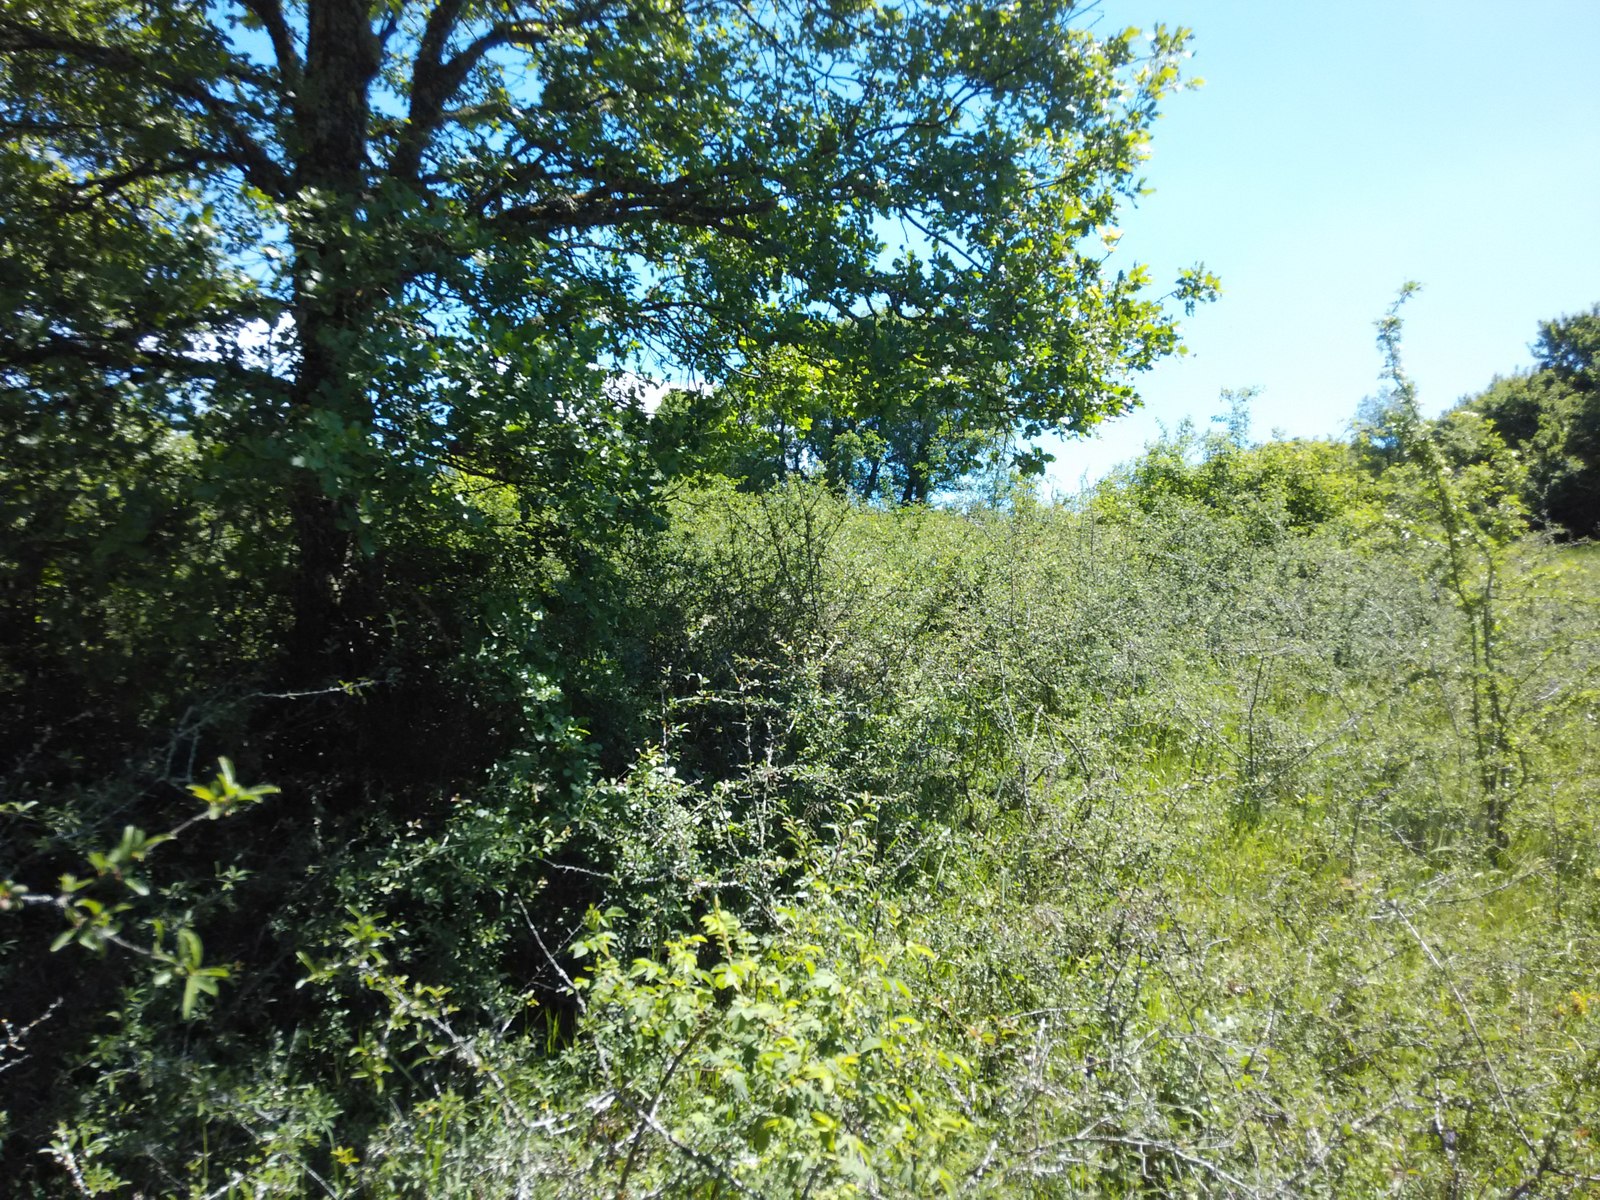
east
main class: Shrubland
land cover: Shrubland with sparse tree cover
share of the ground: > 75 %
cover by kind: shrubs 65 %, herbaceous plants 30 %, broadleaved forest trees 5 %
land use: Forestry
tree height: > 5 m
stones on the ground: < 10 %
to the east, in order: Shrubland with sparse tree cover; Rye; Grassland with sparse tree/shrub cover; Abandoned hedges; Paved roads, cycling and walking lanes; Broadleaved woodland; Rye; Grass margins; Rye
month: May
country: ES
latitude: 42.7615
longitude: -2.4258
